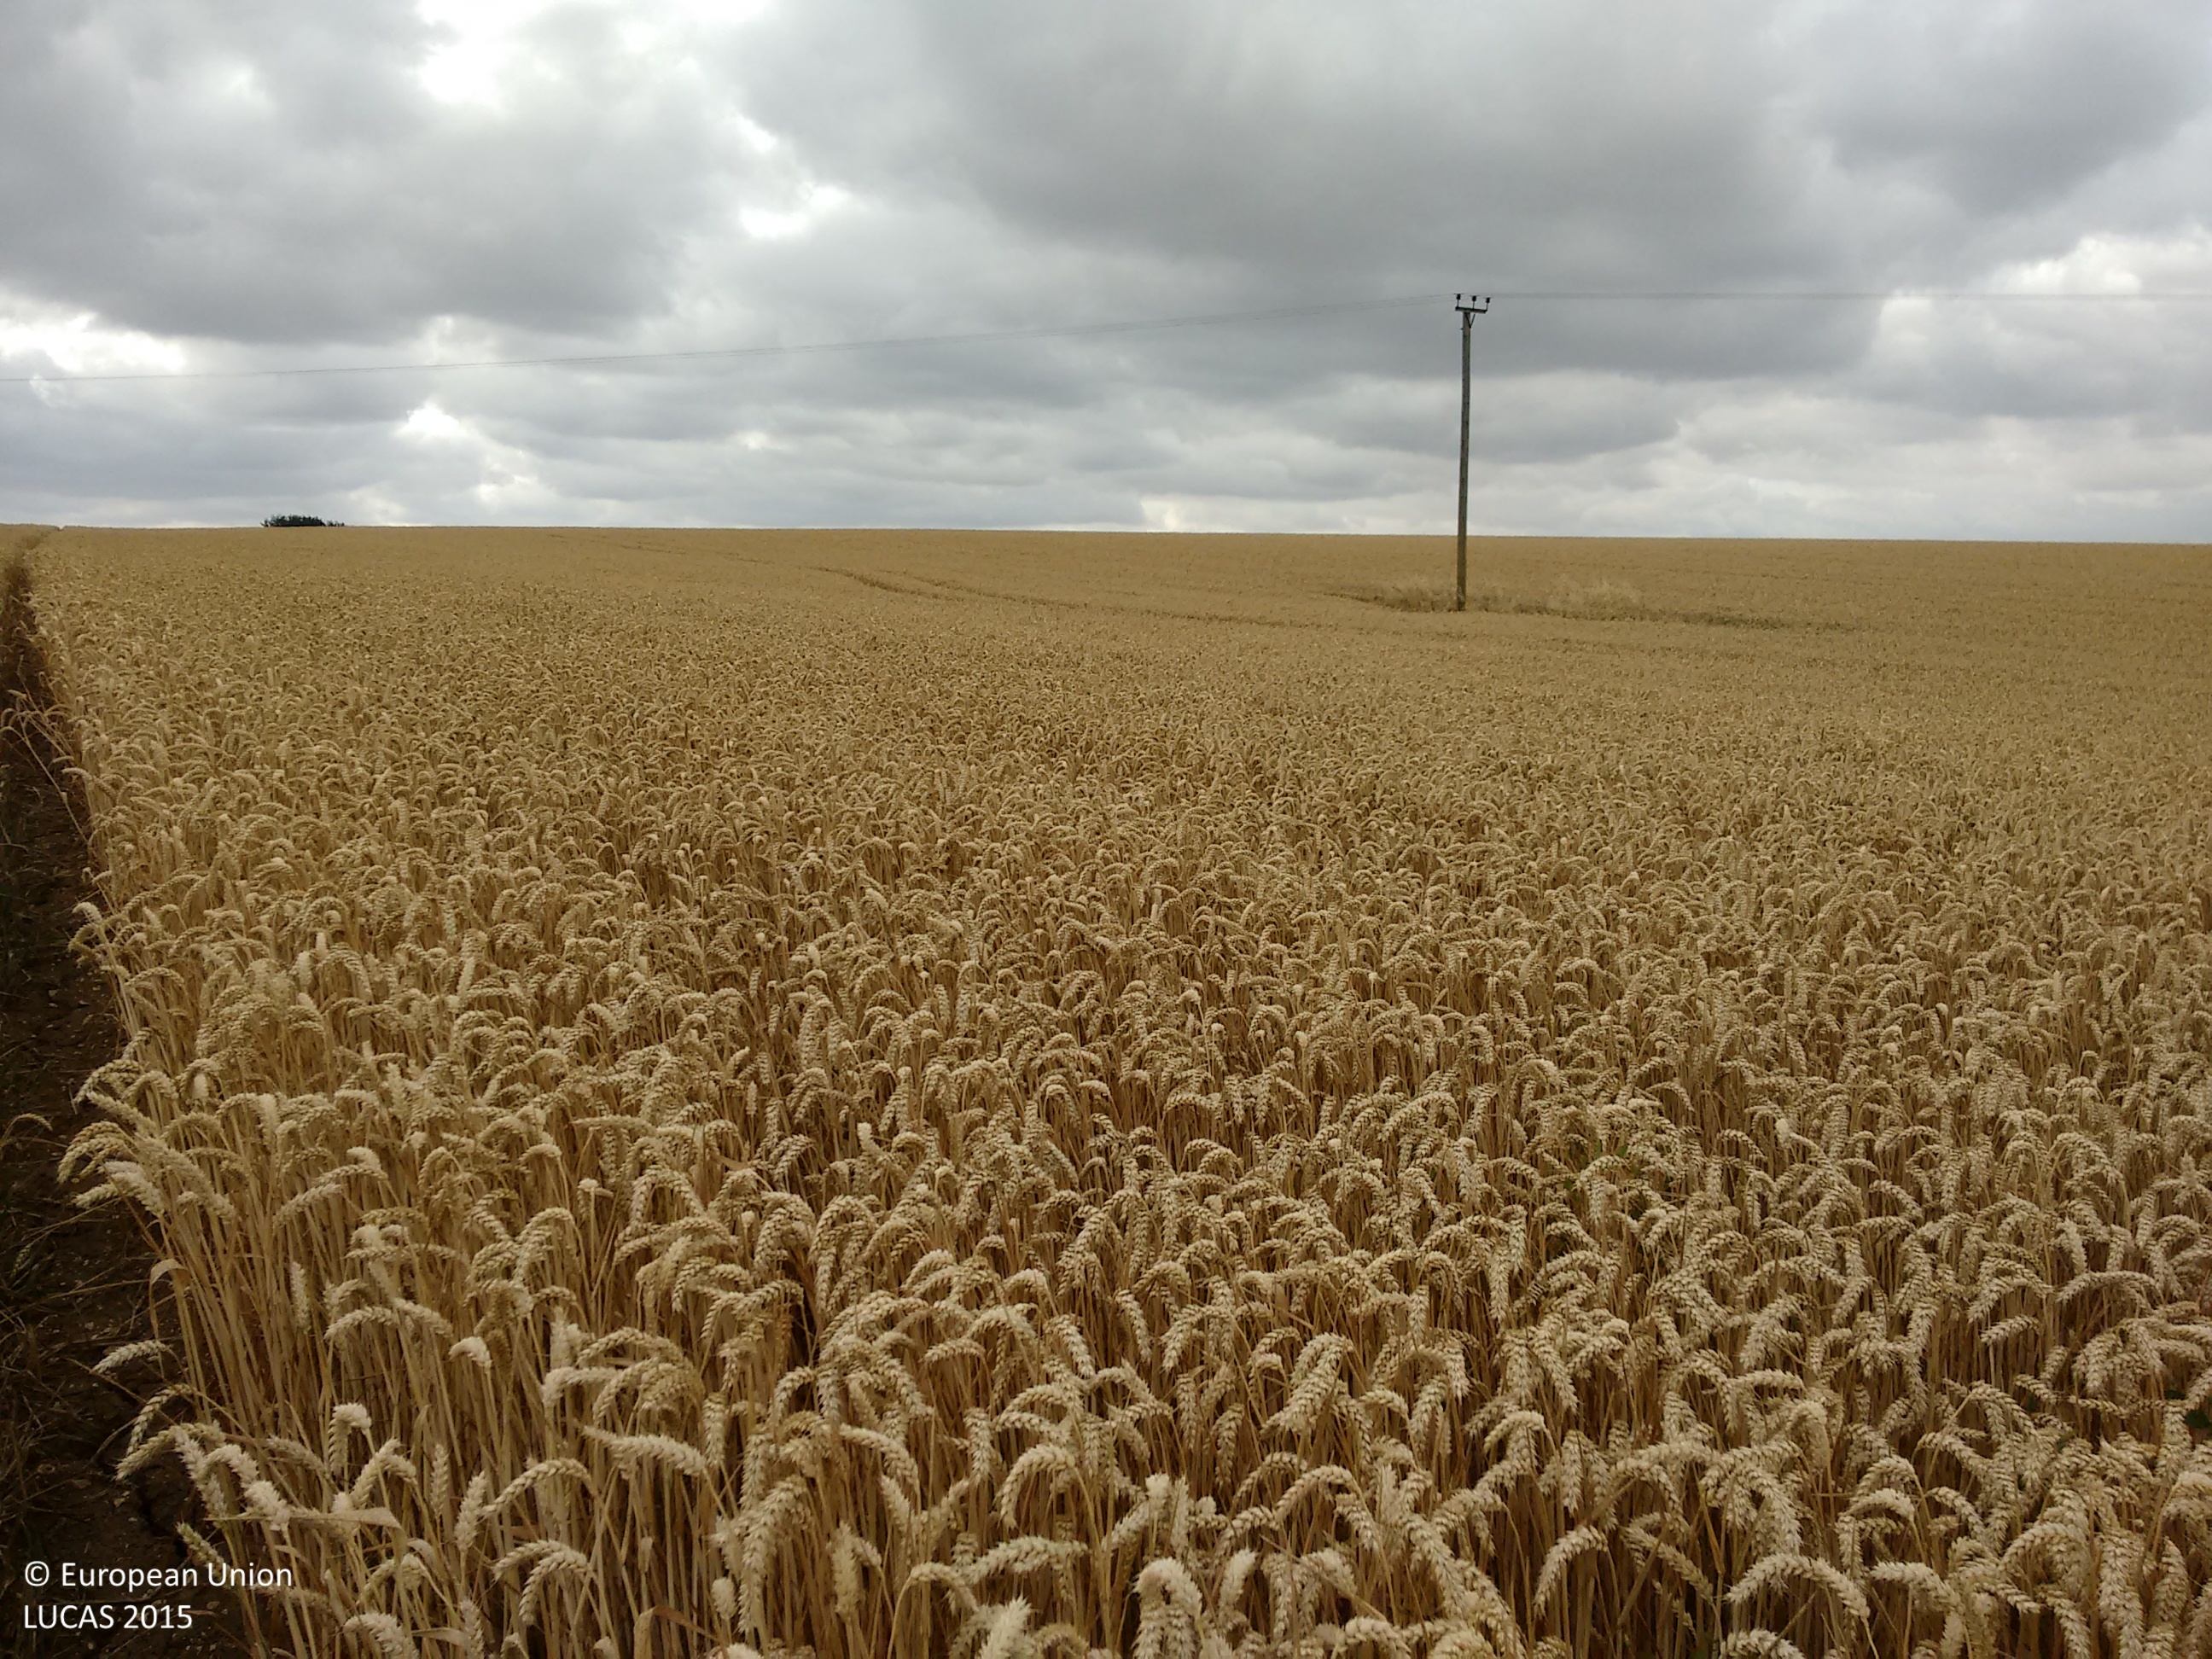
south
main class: Cropland
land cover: Common wheat
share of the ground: > 75 %
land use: Agriculture (excluding fallow land and kitchen gardens)
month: August
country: GB
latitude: 51.9476
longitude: 0.3541
